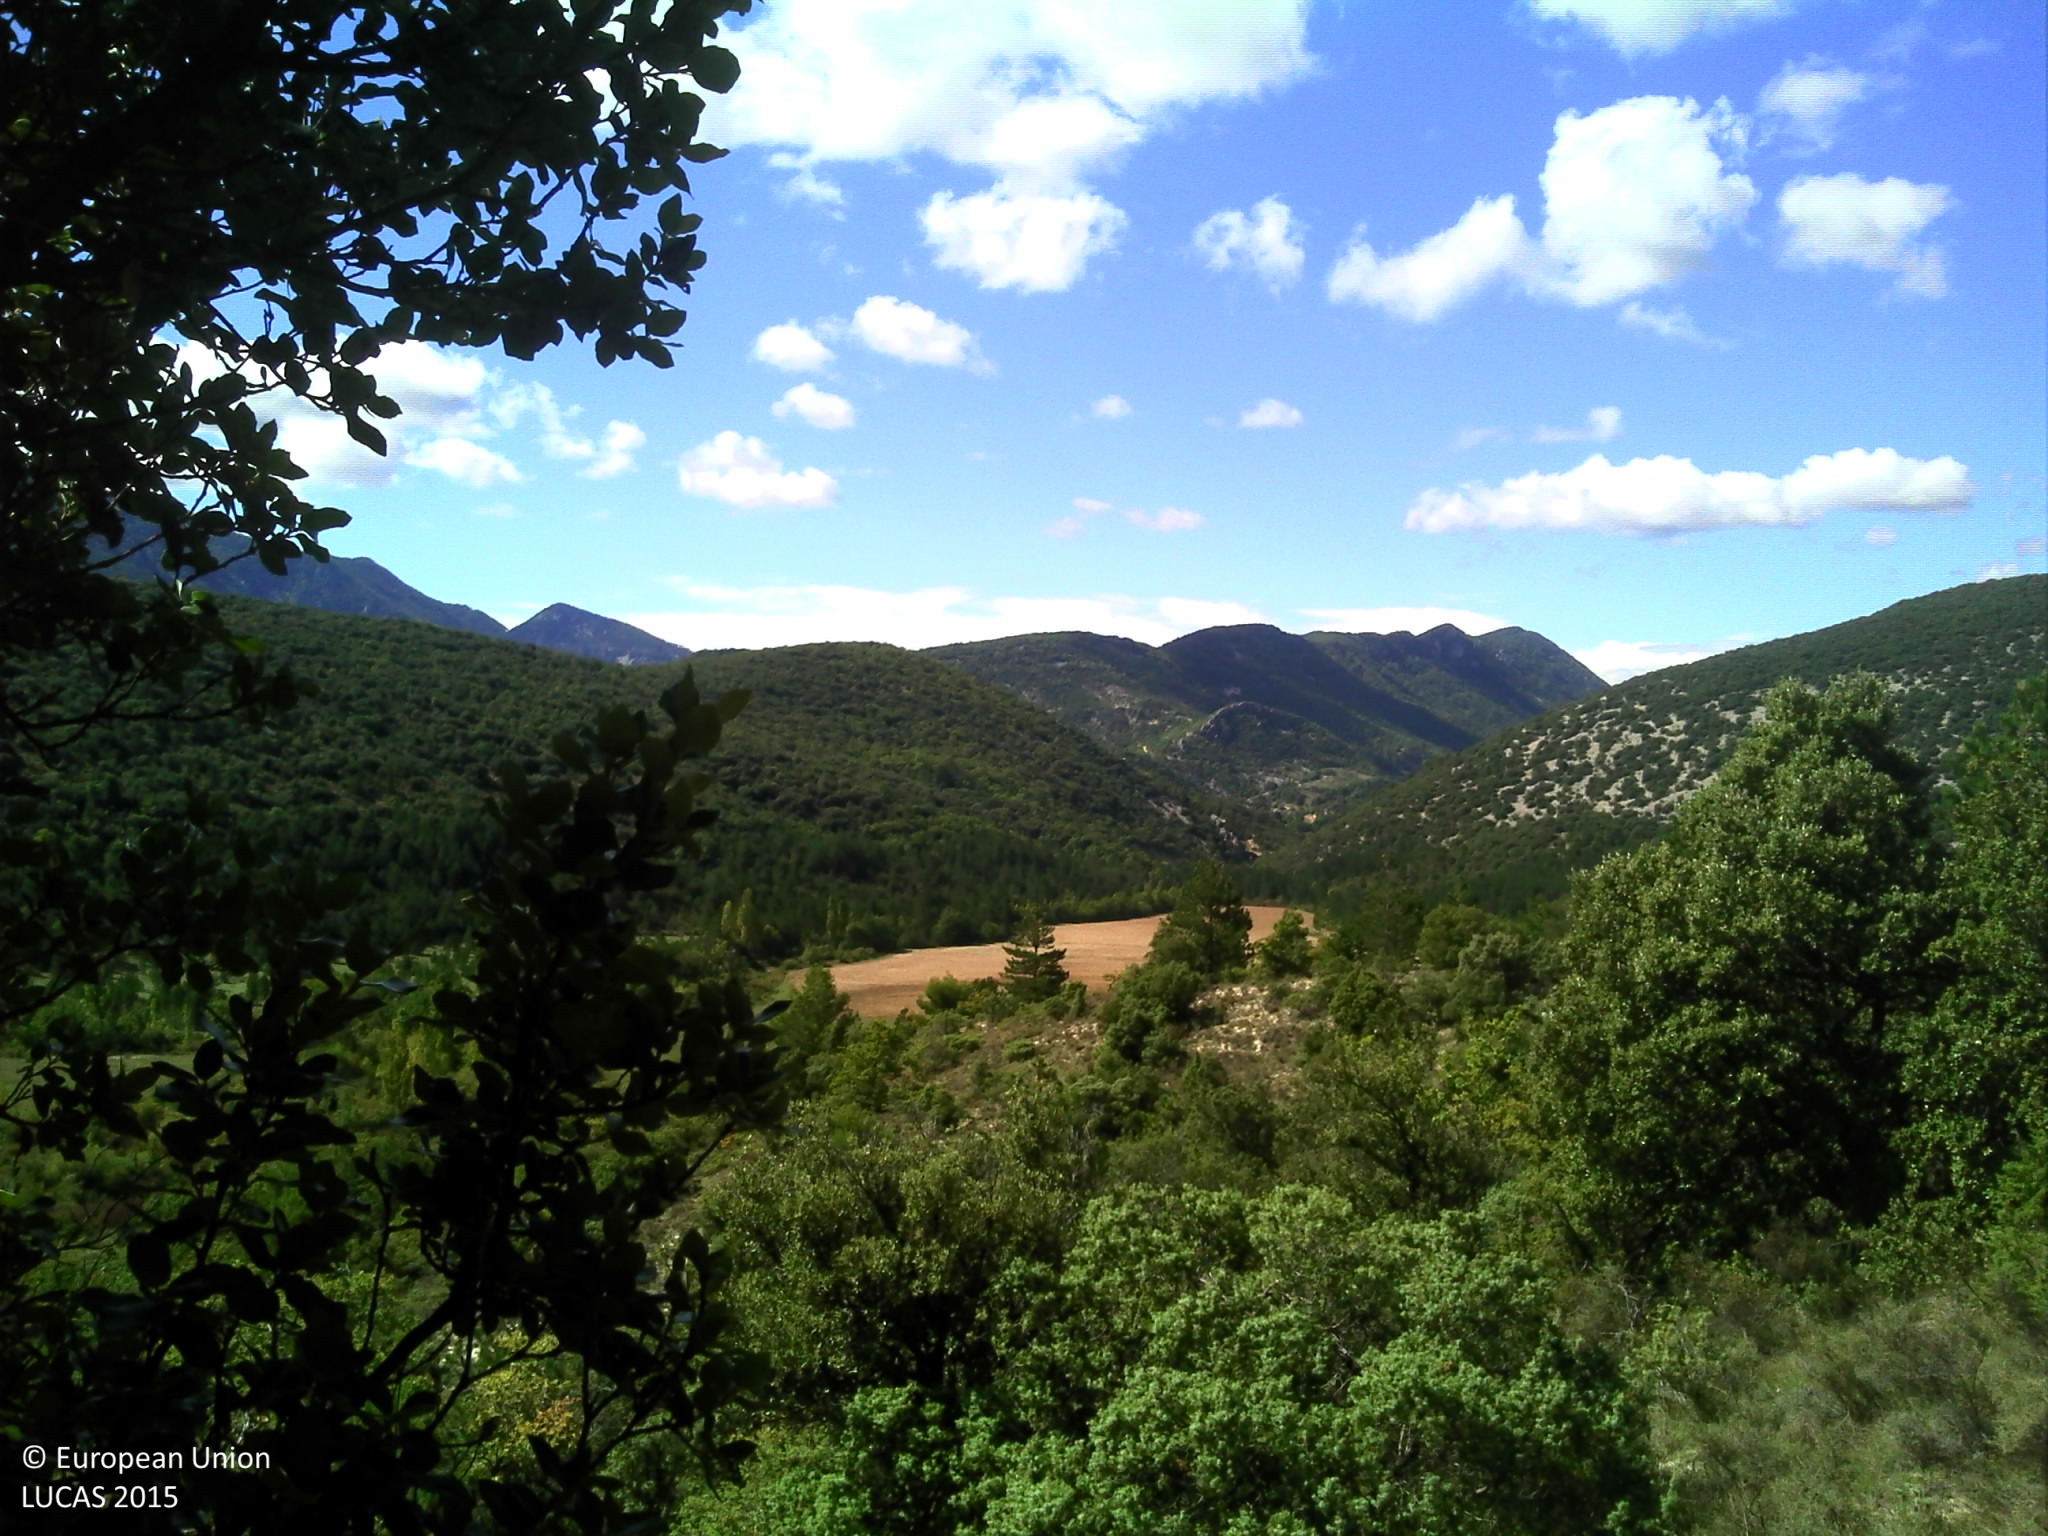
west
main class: Woodland
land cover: Pine dominated mixed woodland
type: coniferous forest of the mediterranean region
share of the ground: 50 - 75 %
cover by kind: shrubs 55 %, broadleaved forest trees 25 %, coniferous forest trees 20 %
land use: Agriculture (excluding fallow land and kitchen gardens)
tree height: < 5 m
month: September
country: FR
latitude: 44.2098
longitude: 5.3397
